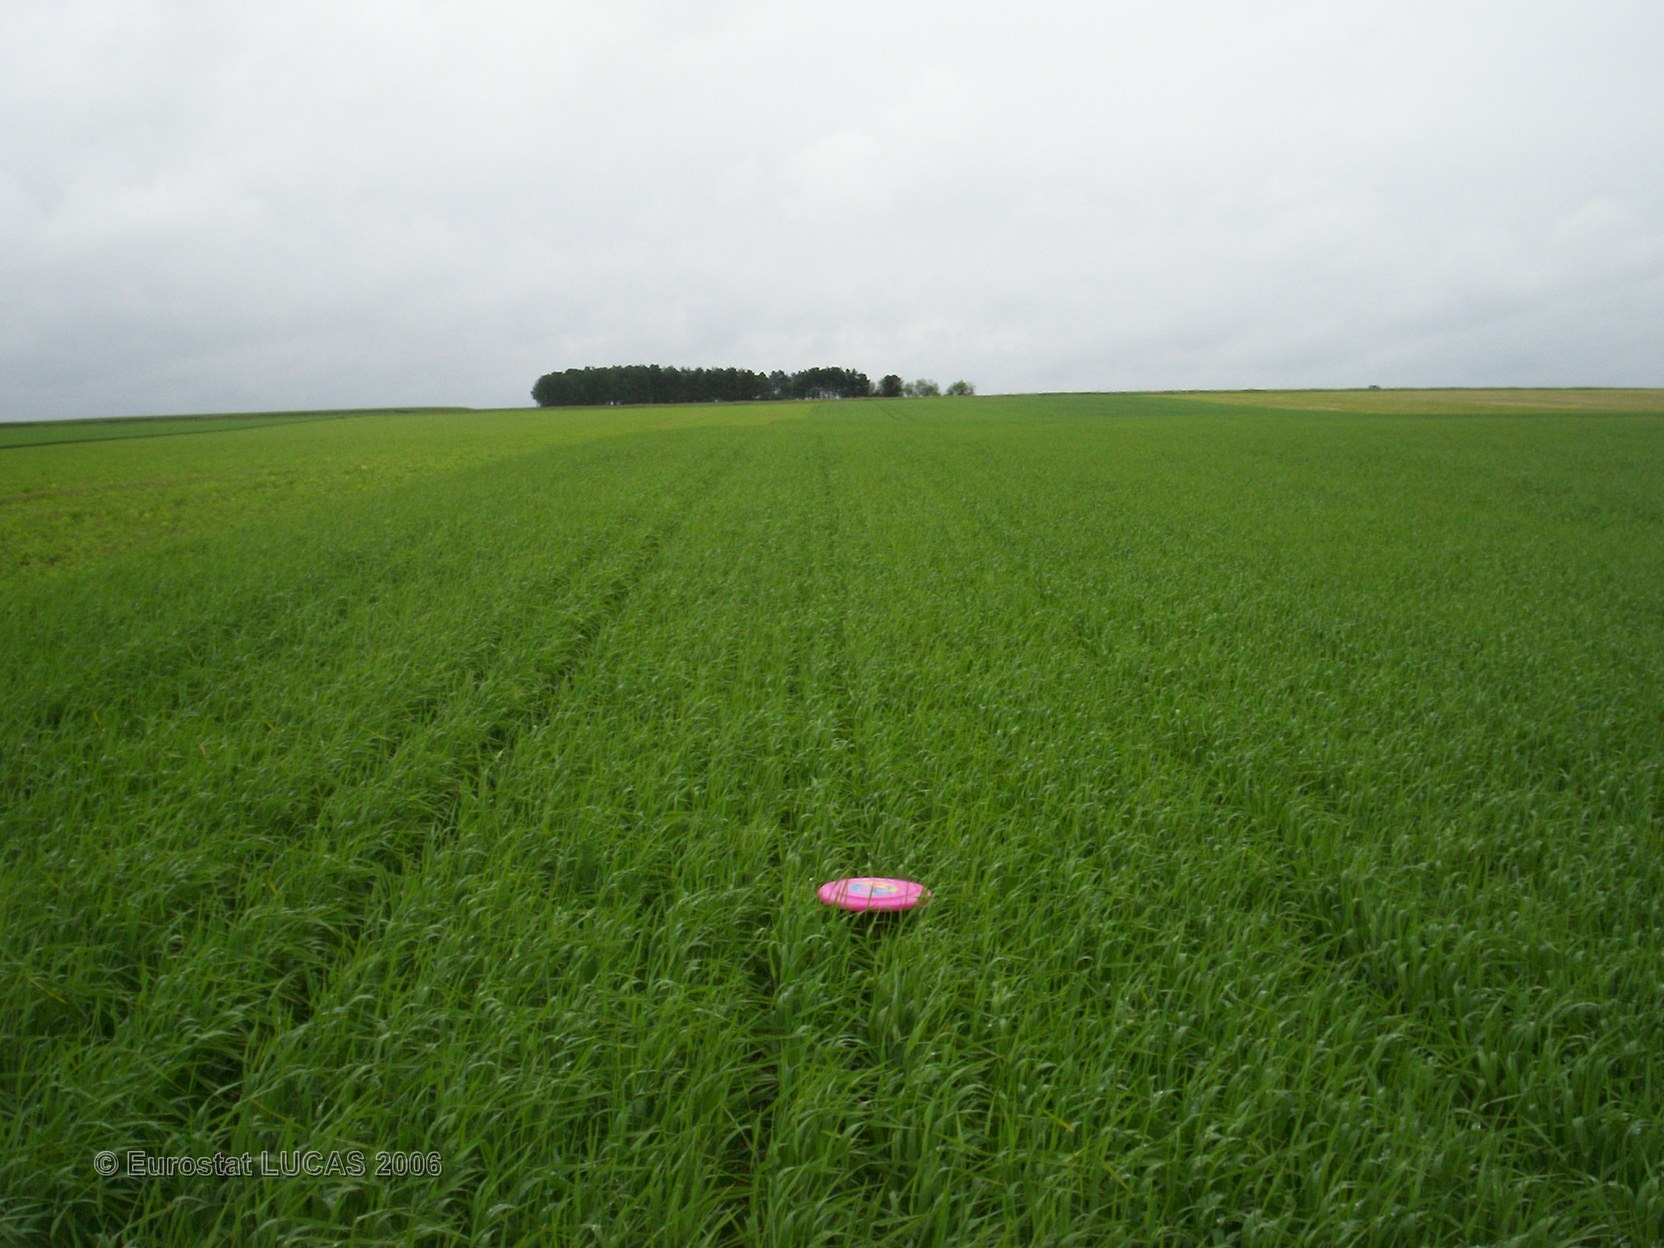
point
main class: Cropland
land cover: Barley
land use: Agriculture (excluding fallow land and kitchen gardens)
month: May
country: FR
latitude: 49.3281
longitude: 4.4511
